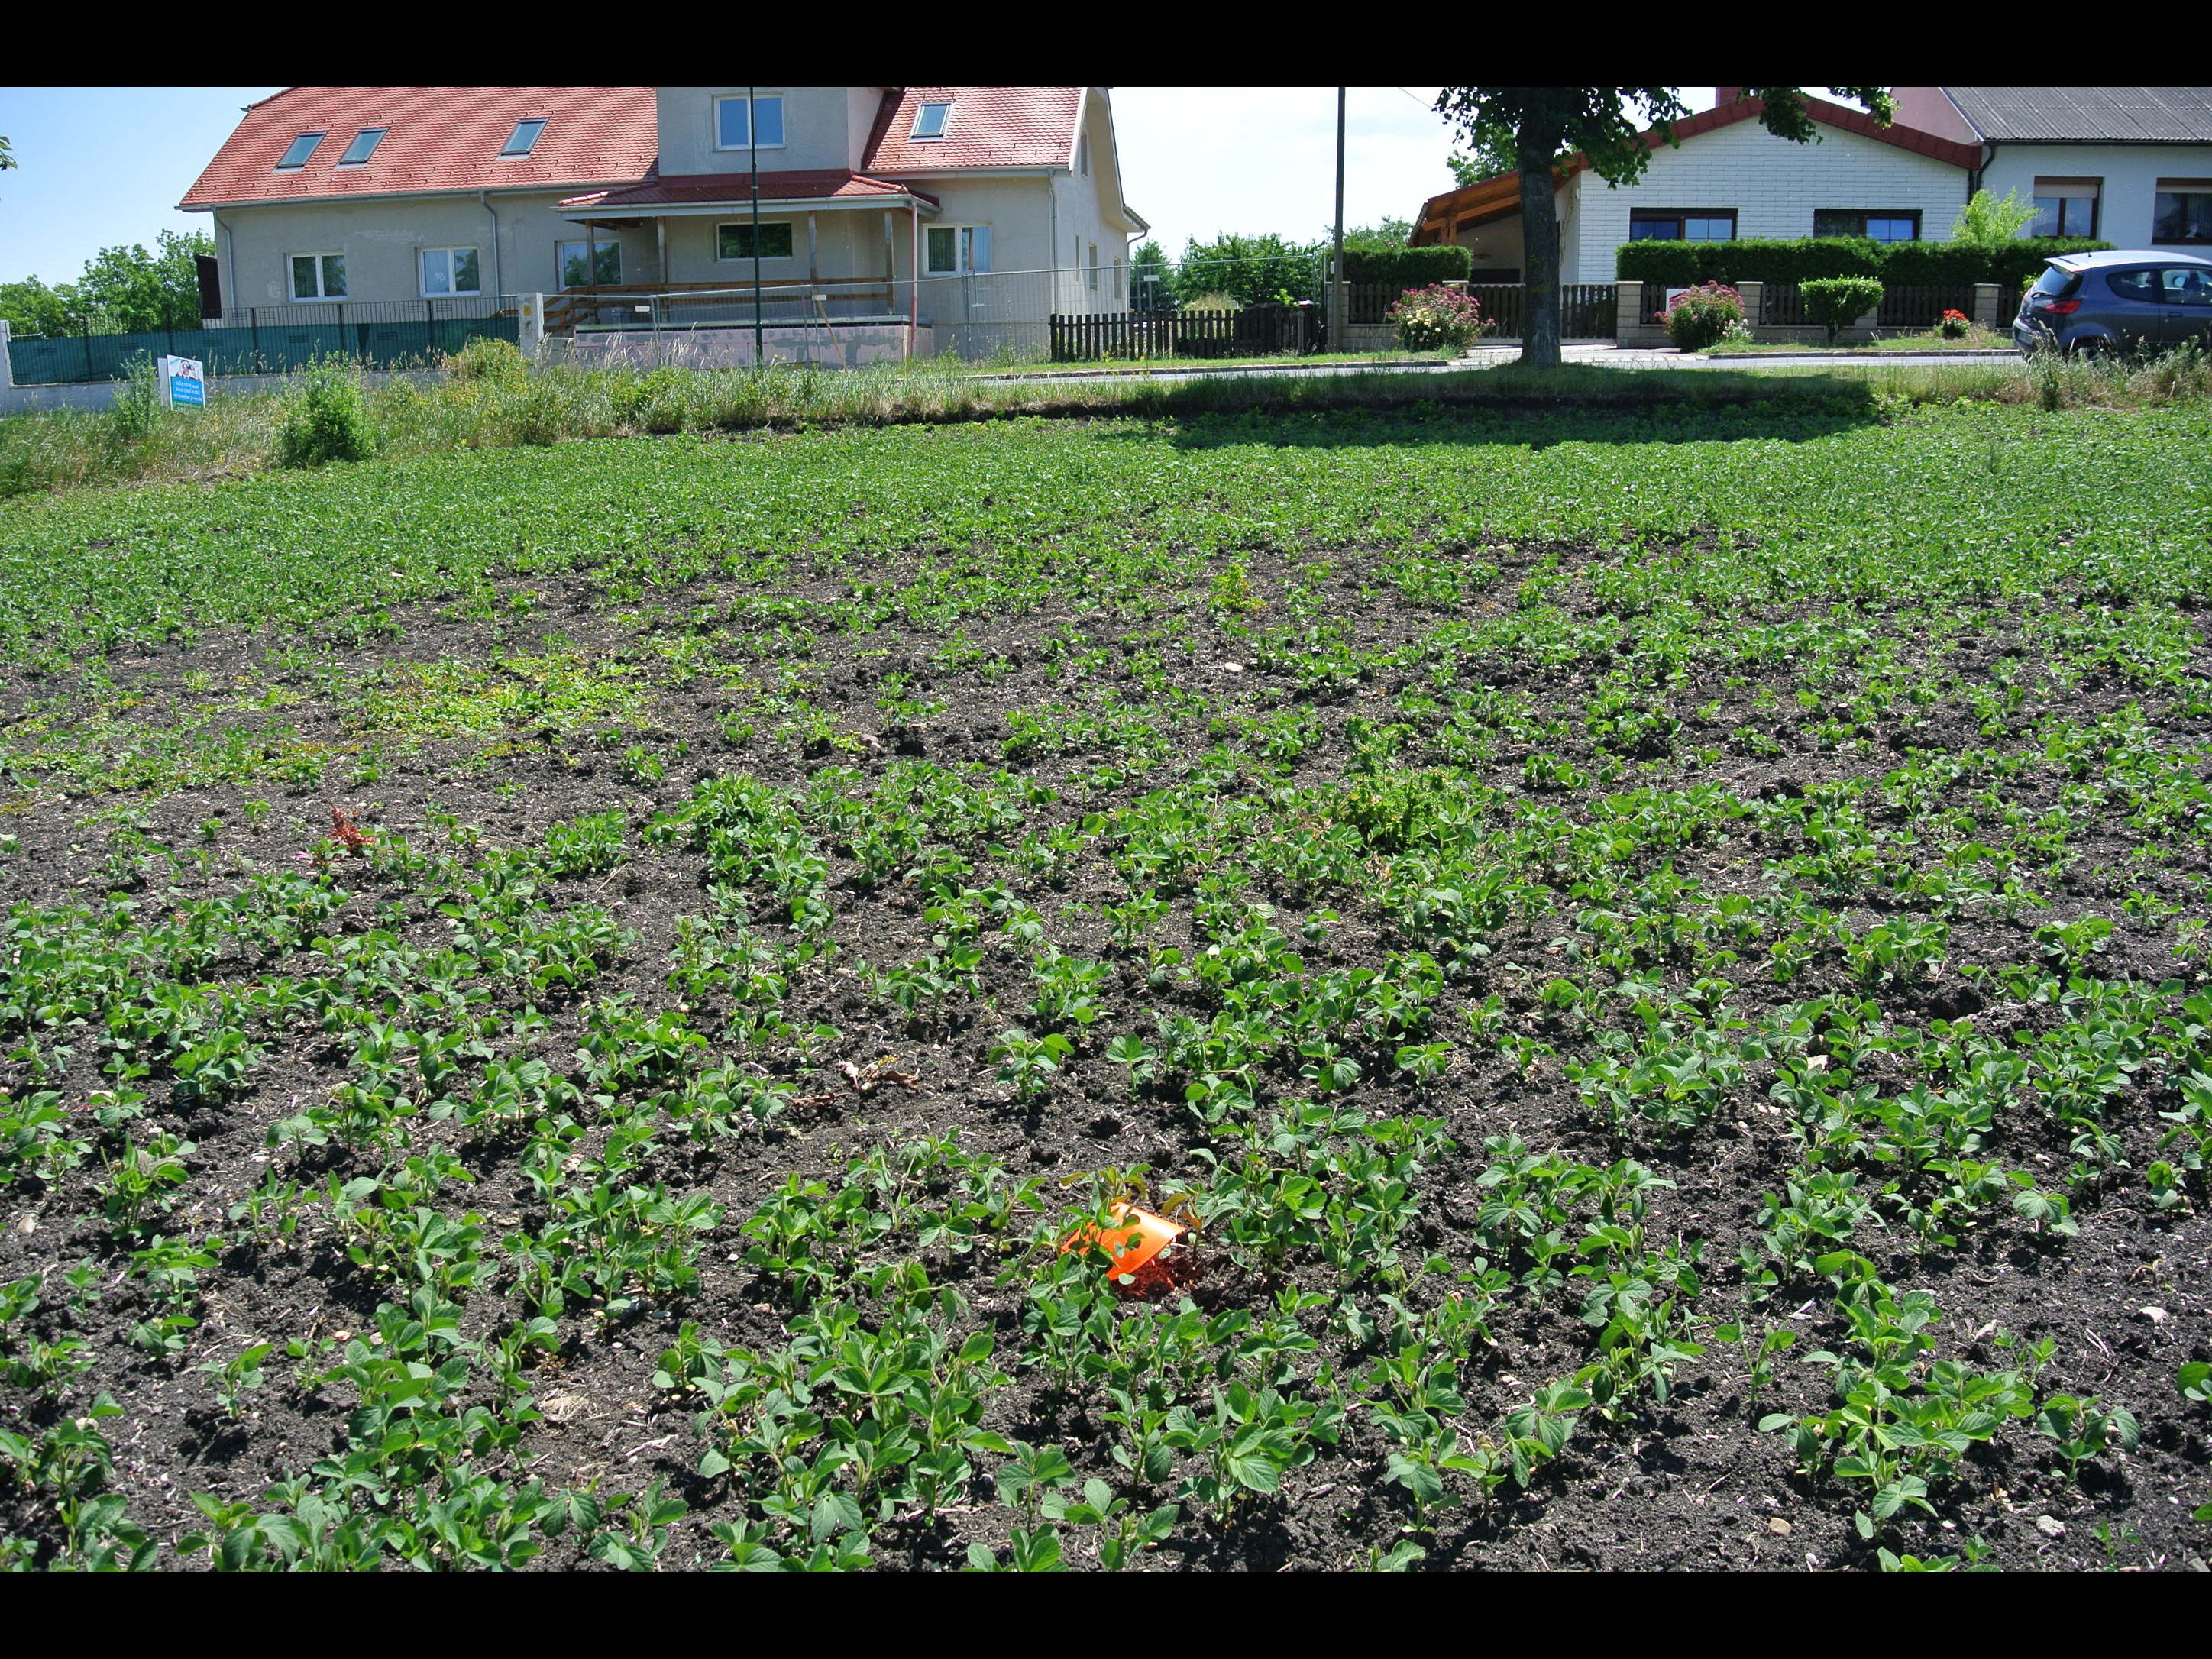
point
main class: Cropland
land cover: Soya
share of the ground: > 75 %
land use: Agriculture (excluding fallow land and kitchen gardens)
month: June
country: AT
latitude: 47.7818
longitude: 16.4507
